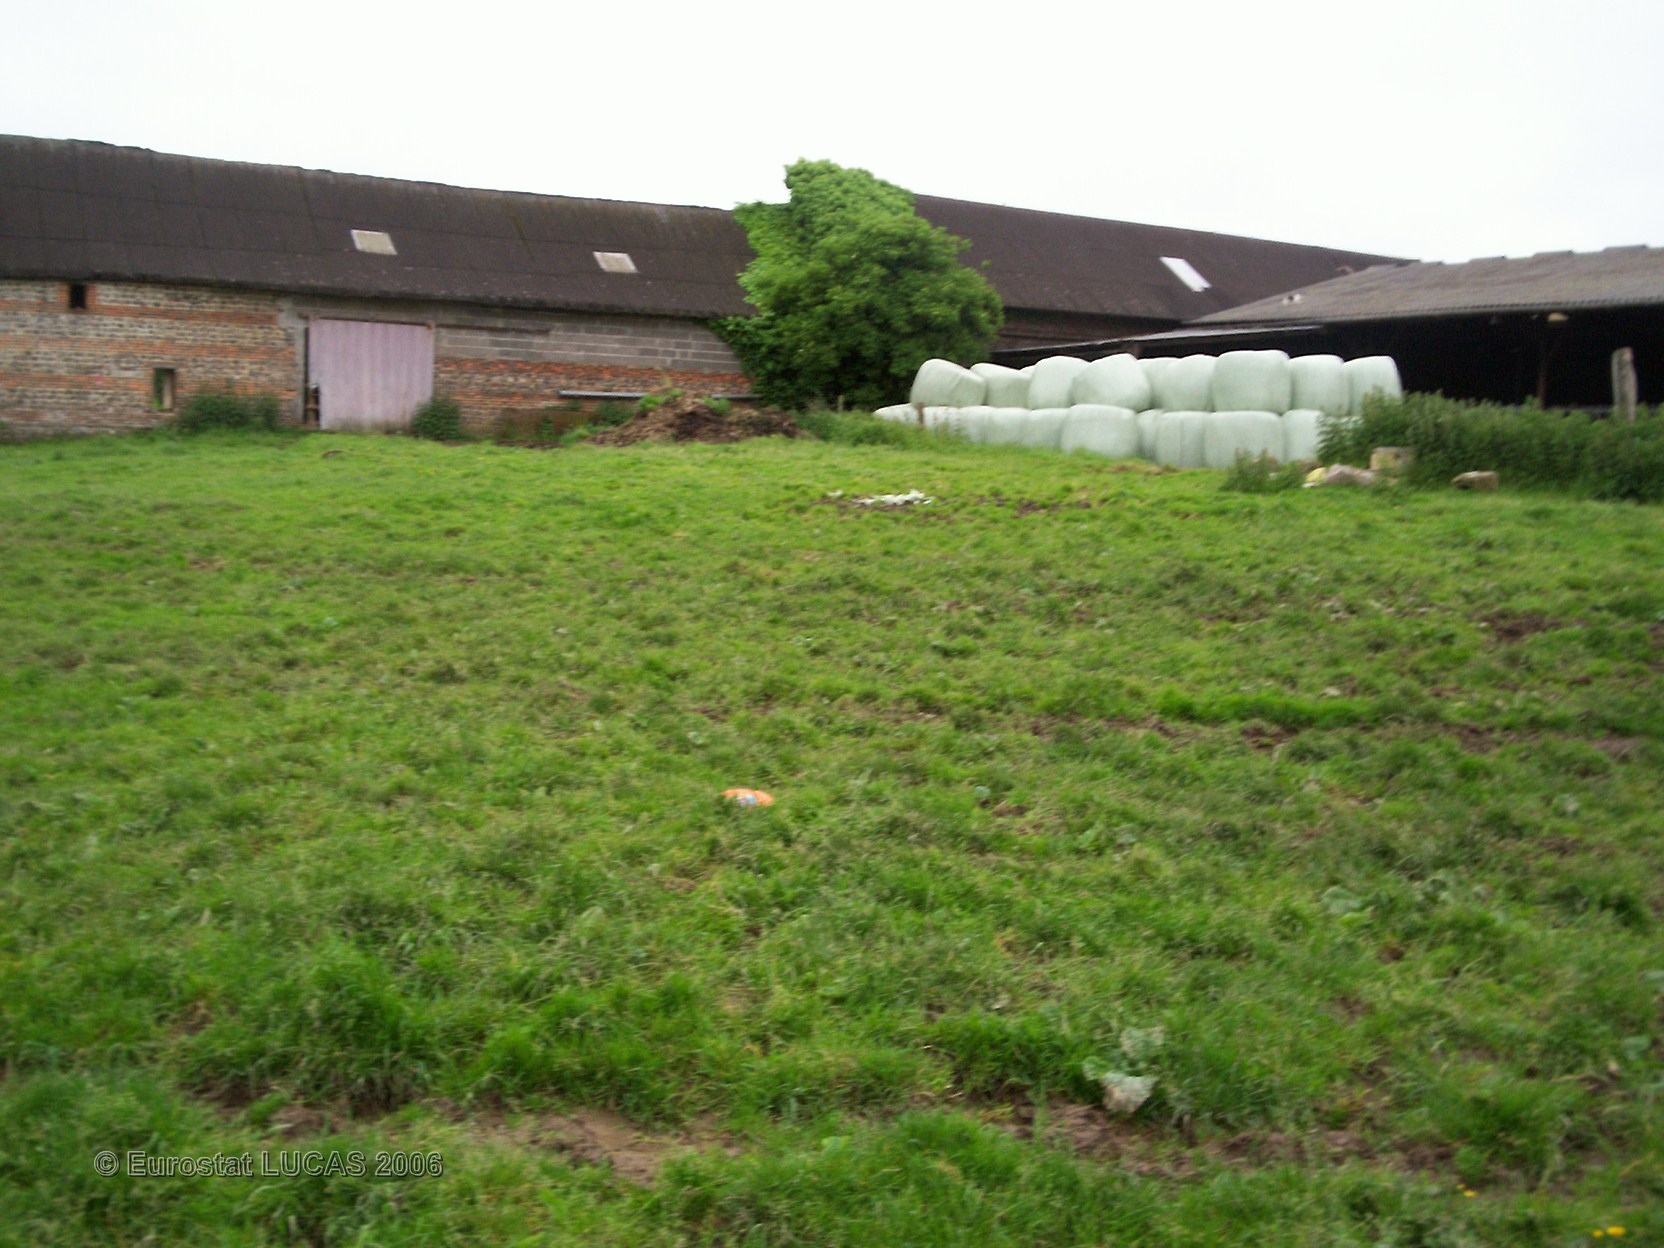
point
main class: Grassland
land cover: Grassland without tree/shrub cover
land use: Agriculture (excluding fallow land and kitchen gardens)
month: May
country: FR
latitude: 49.5982
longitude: 0.4119
